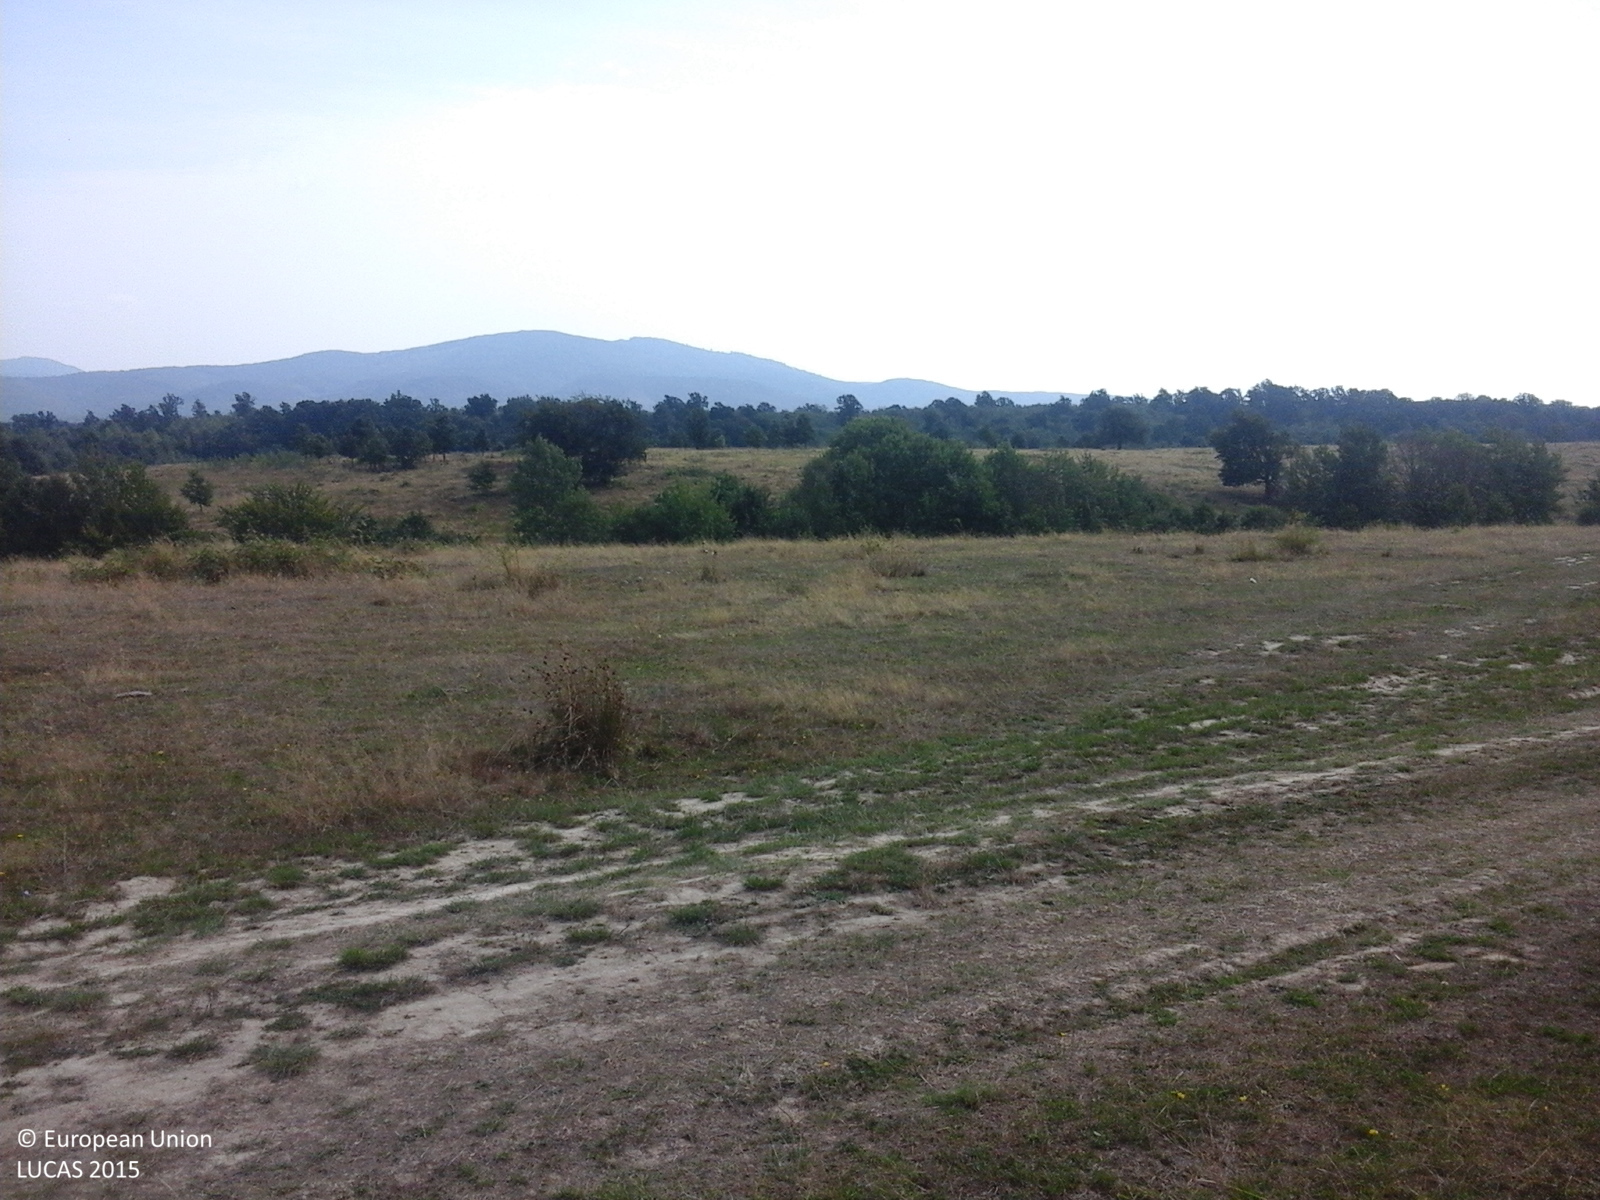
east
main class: Grassland
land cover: Grassland with sparse tree/shrub cover
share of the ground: > 75 %
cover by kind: herbaceous plants 85 %, shrubs 10 %, broadleaved forest trees 5 %
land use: Agriculture (excluding fallow land and kitchen gardens)
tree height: < 5 m
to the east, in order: Grassland with sparse tree/shrub cover; Tracks; Grassland with sparse tree/shrub cover; Broadleaved woodland; Ditches and canals; Grassland with sparse tree/shrub cover
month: August
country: RO
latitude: 46.3601
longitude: 22.1985
